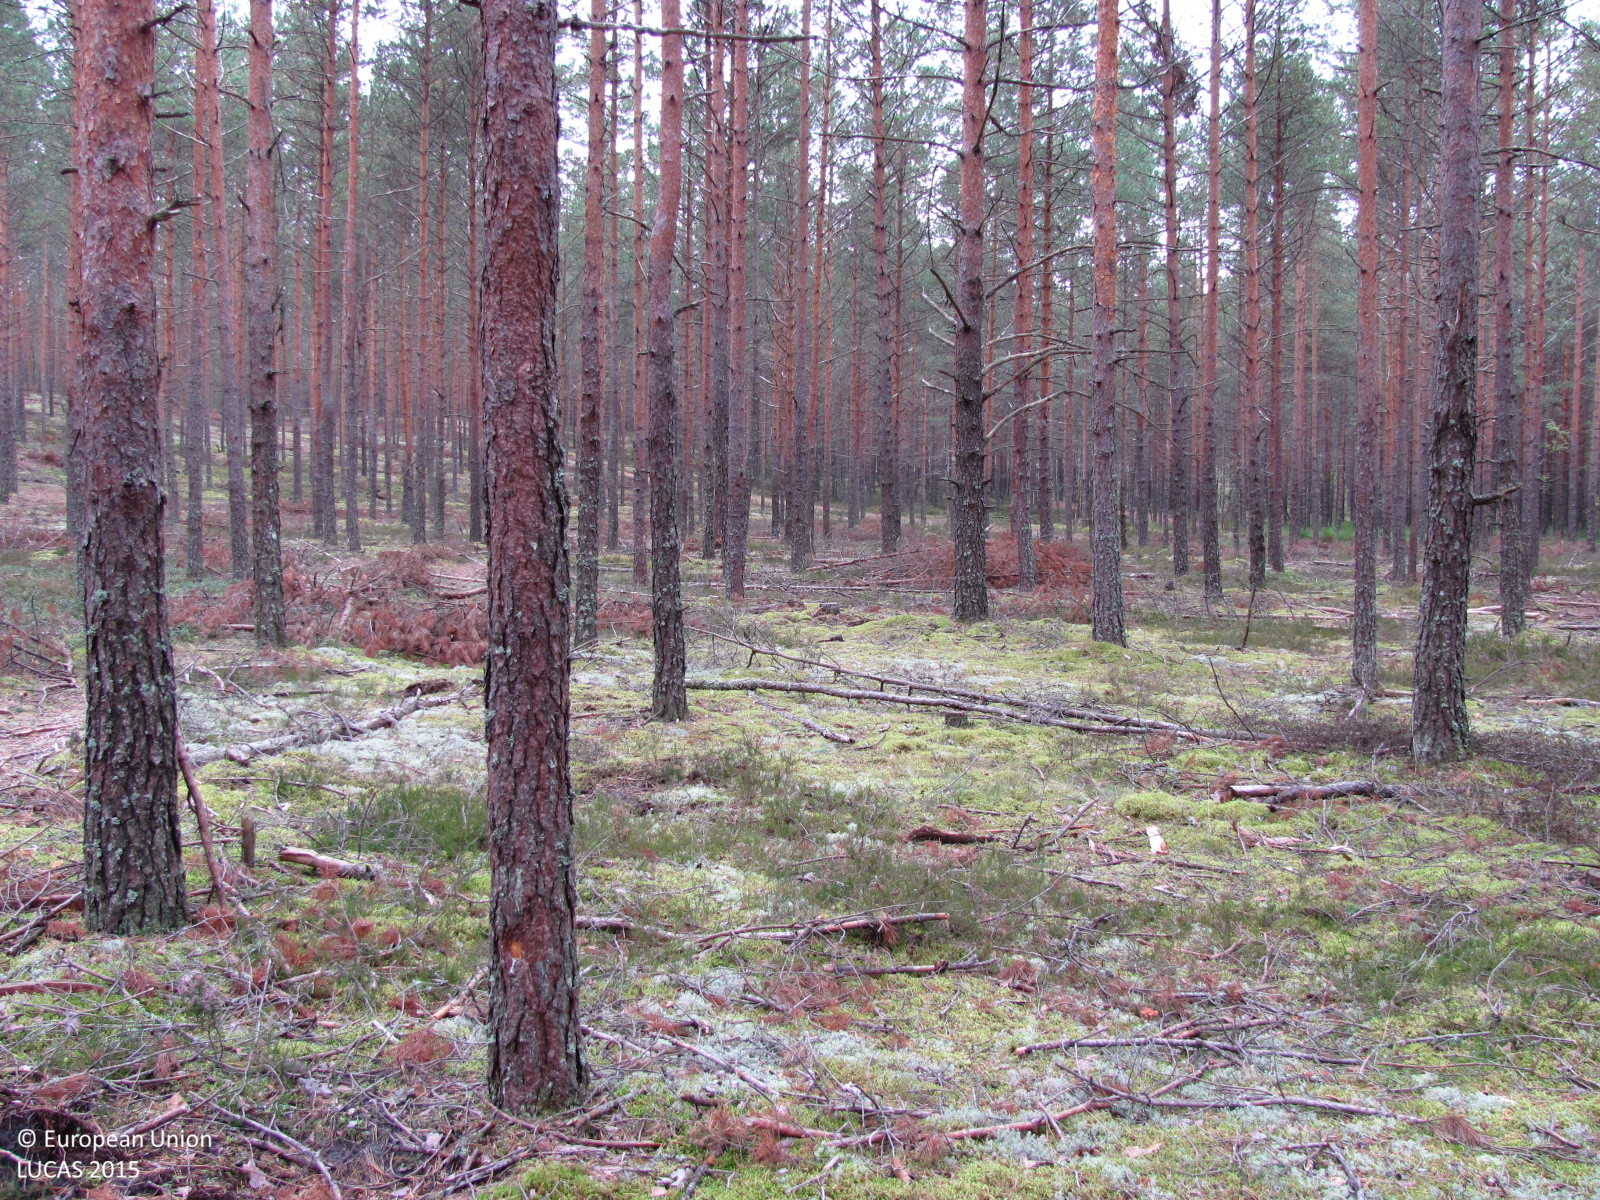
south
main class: Woodland
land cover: Pine dominated coniferous woodland
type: hemiboreal forest and nemoral coniferous forest and mixed broadleaved-coniferous forest
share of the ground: > 75 %
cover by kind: coniferous forest trees 80 %, lichens and mosses 15 %, herbaceous plants 5 %
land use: Forestry
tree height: > 5 m
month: September
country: LV
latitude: 57.0759
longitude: 24.5281
